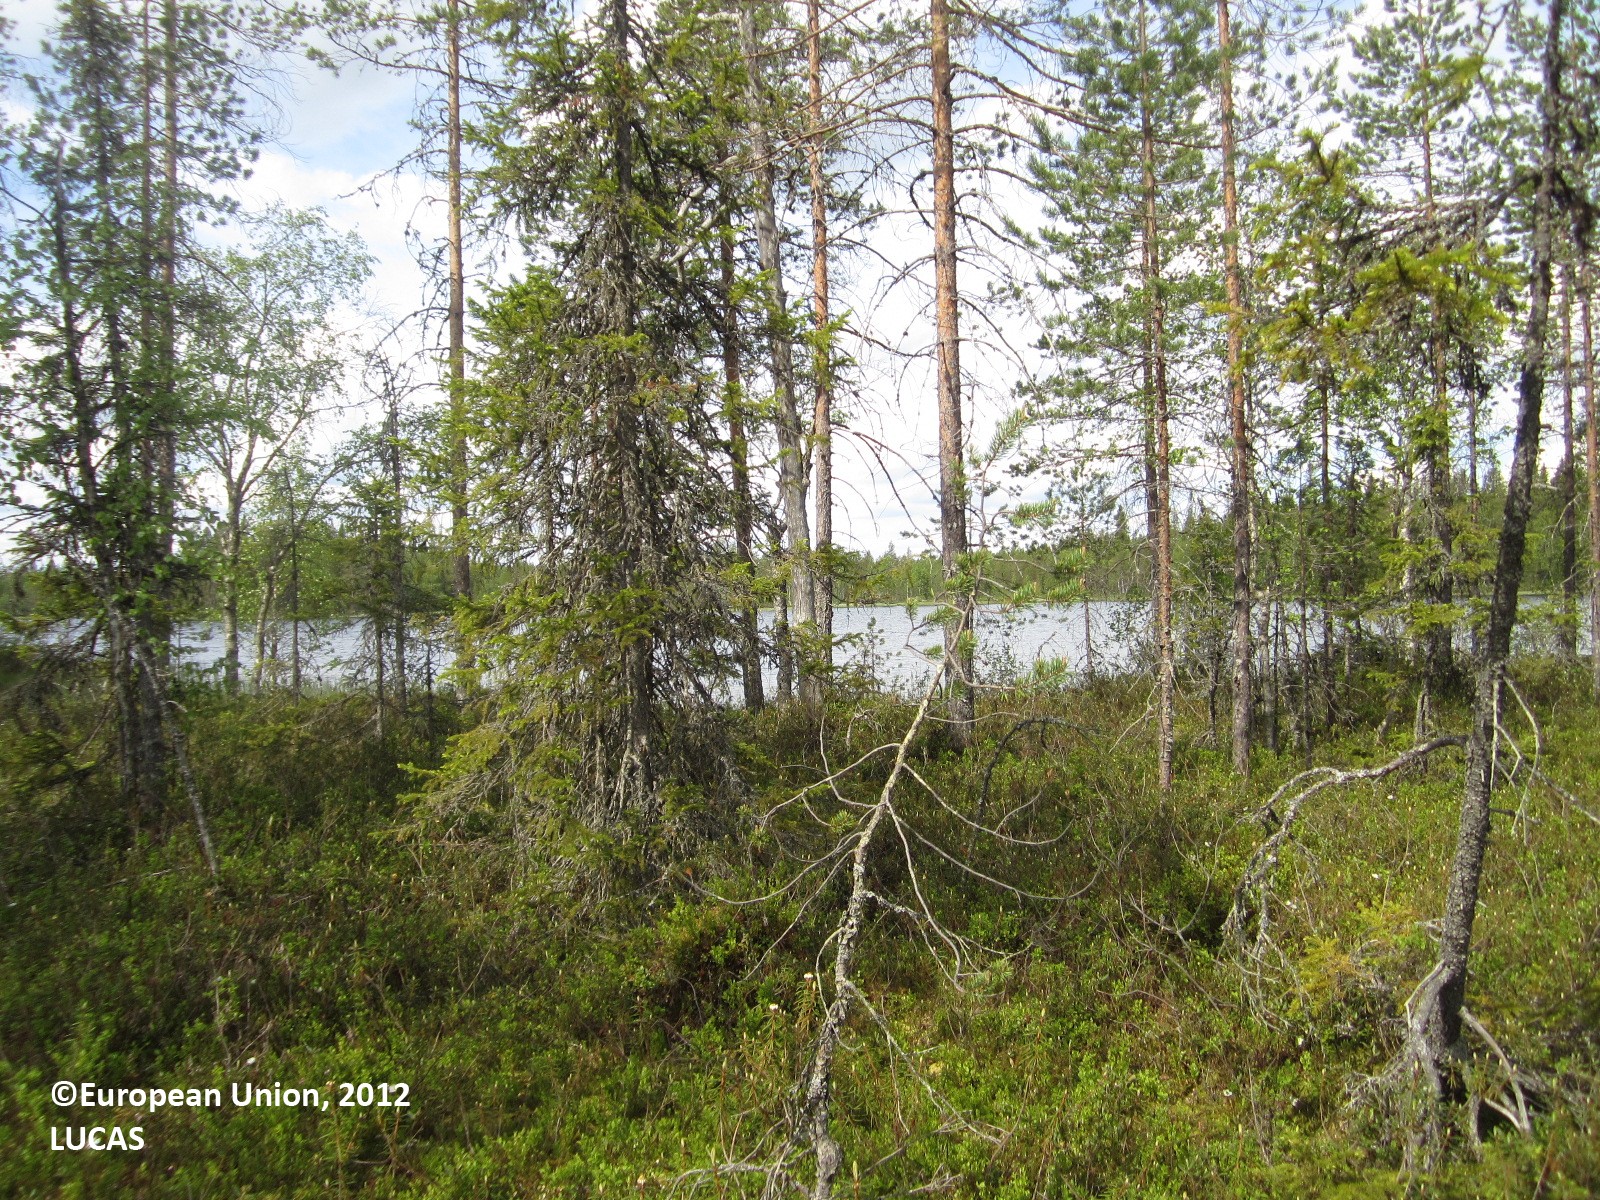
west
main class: Woodland
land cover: Pine dominated coniferous woodland
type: boreal forest
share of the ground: 25 - 50 %
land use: Forestry
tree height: > 5 m
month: June
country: FI
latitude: 64.9410
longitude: 29.2629
